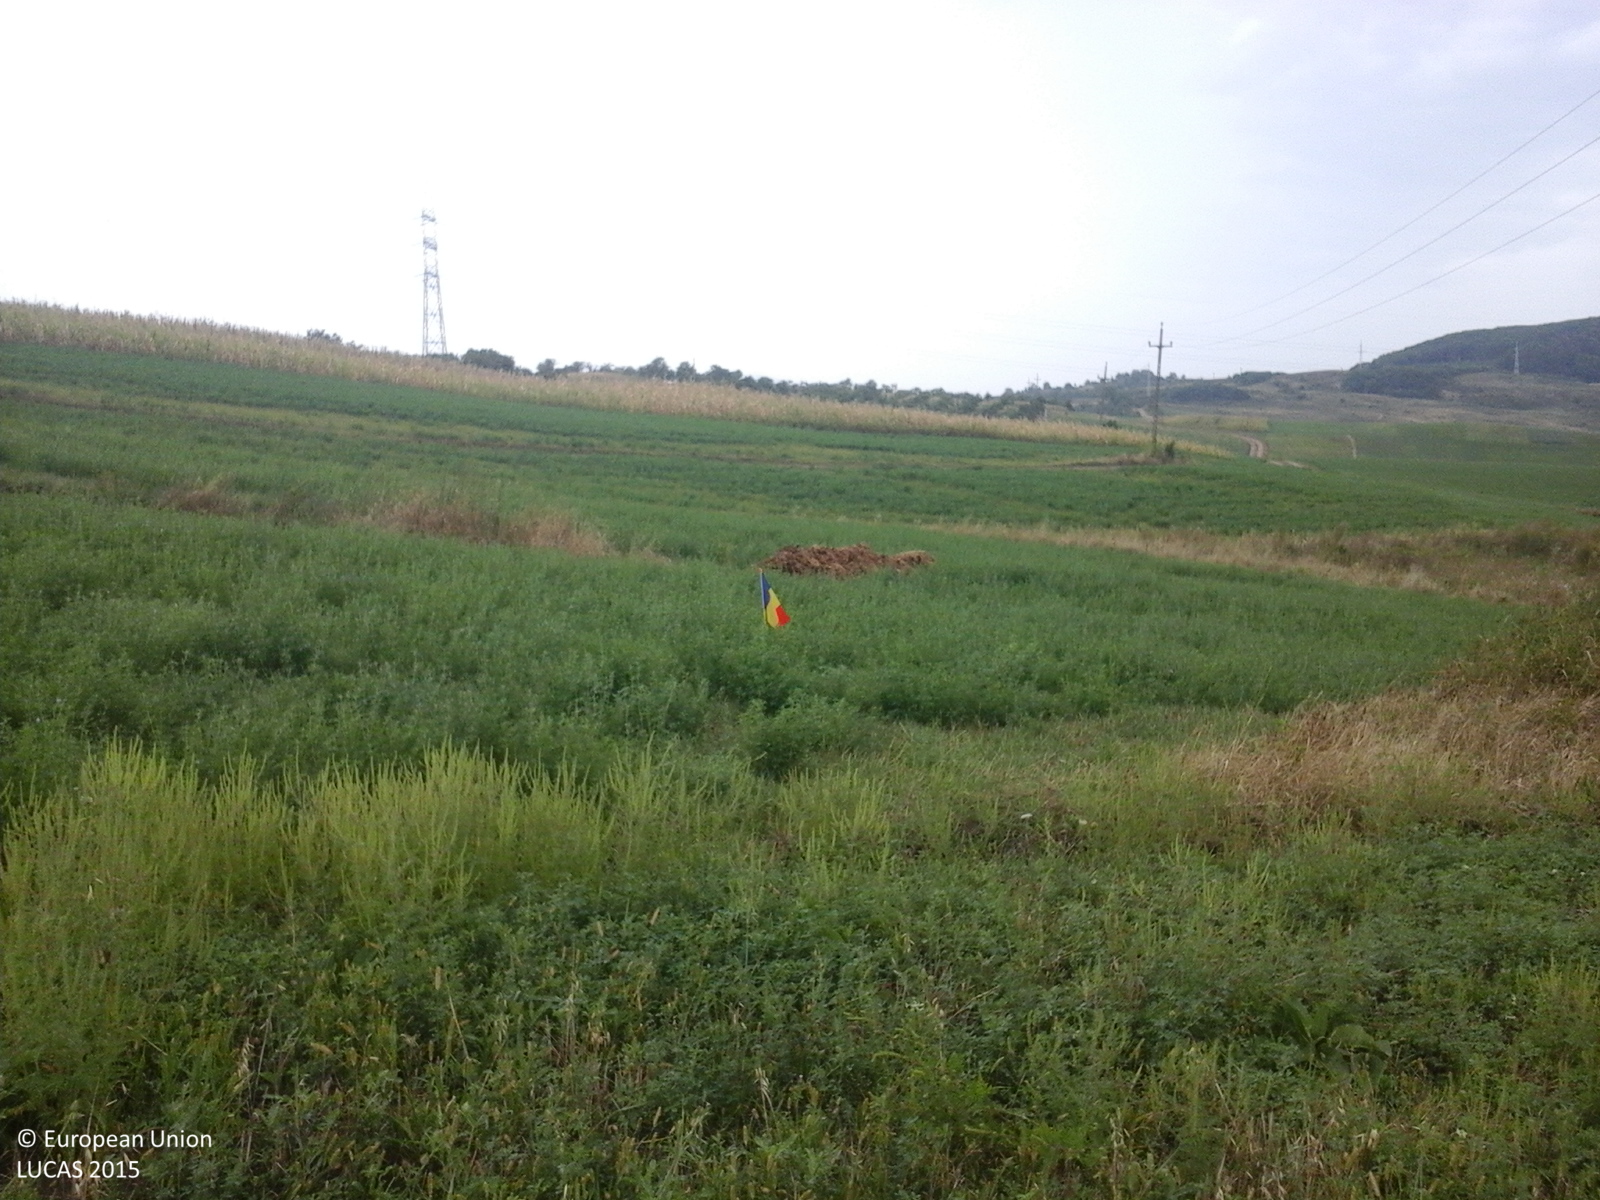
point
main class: Cropland
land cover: Lucerne
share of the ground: > 75 %
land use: Agriculture (excluding fallow land and kitchen gardens)
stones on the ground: < 10 %
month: September
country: RO
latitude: 47.2191
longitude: 23.0986
